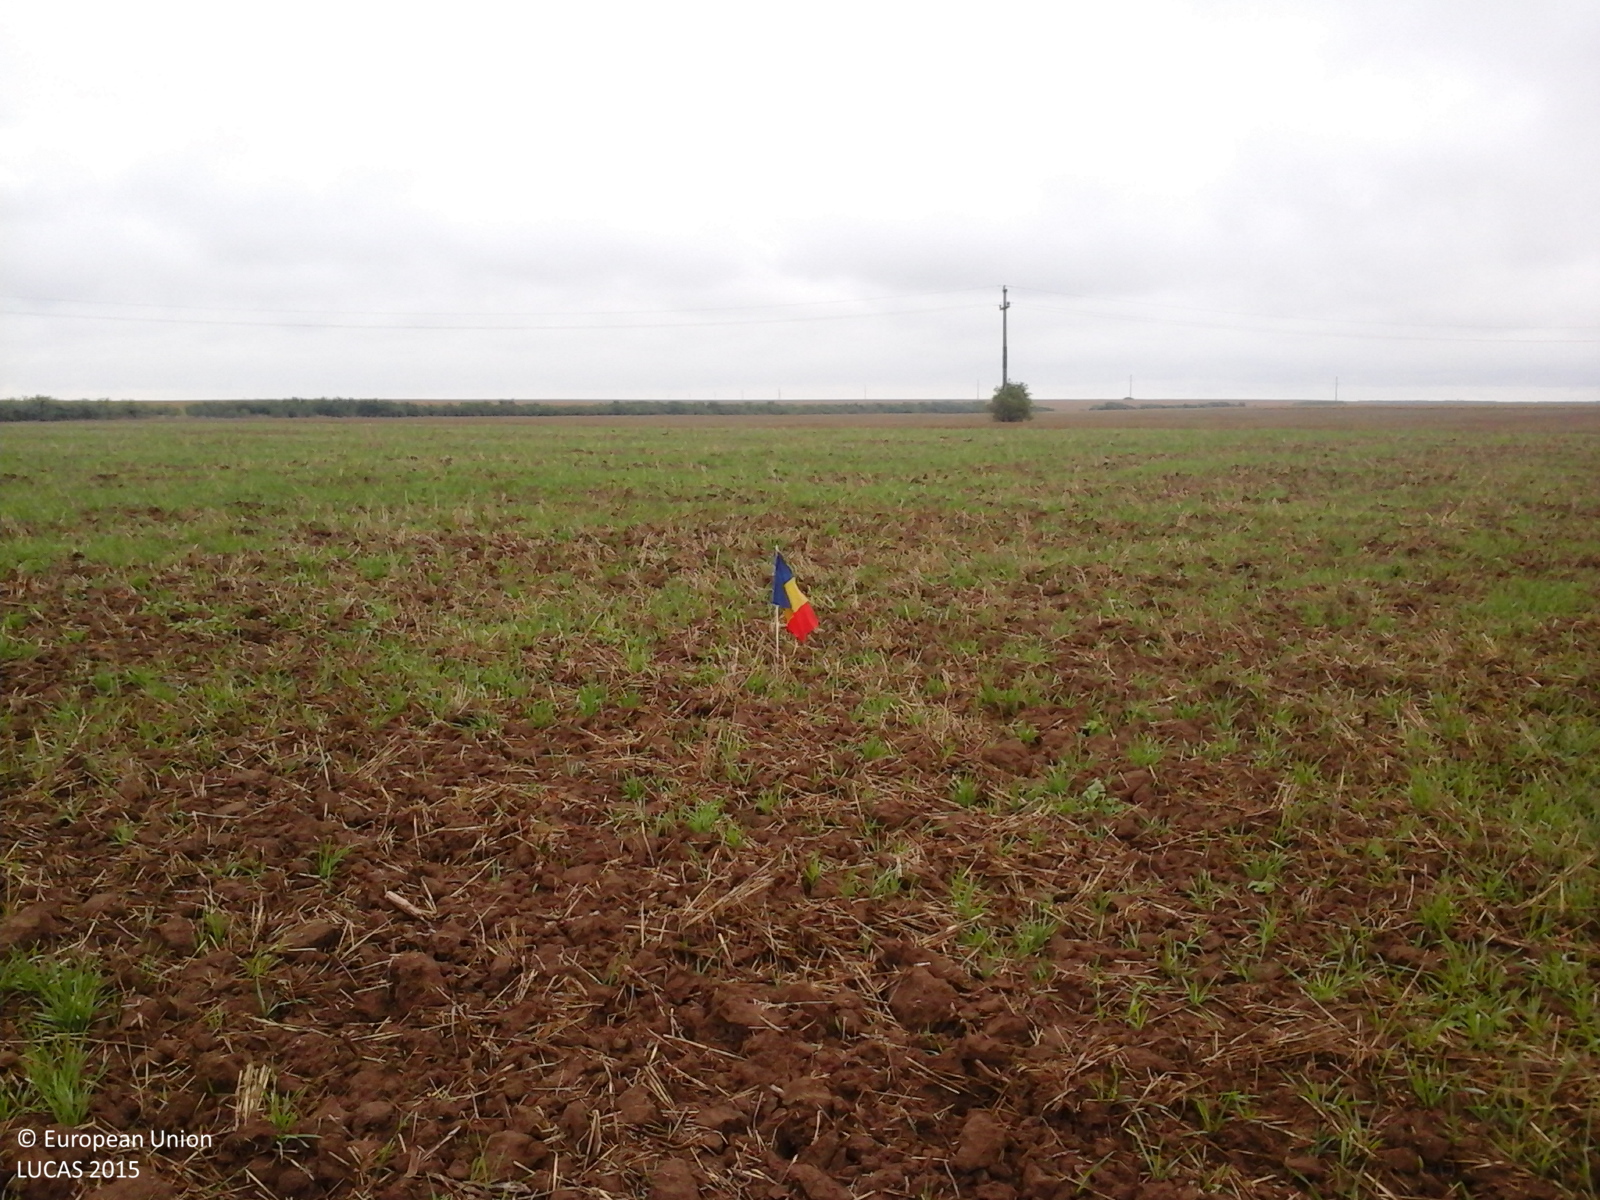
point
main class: Cropland
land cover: Common wheat
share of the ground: 25 - 50 %
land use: Agriculture (excluding fallow land and kitchen gardens)
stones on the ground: < 10 %
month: September
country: RO
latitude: 46.9561
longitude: 21.7515
